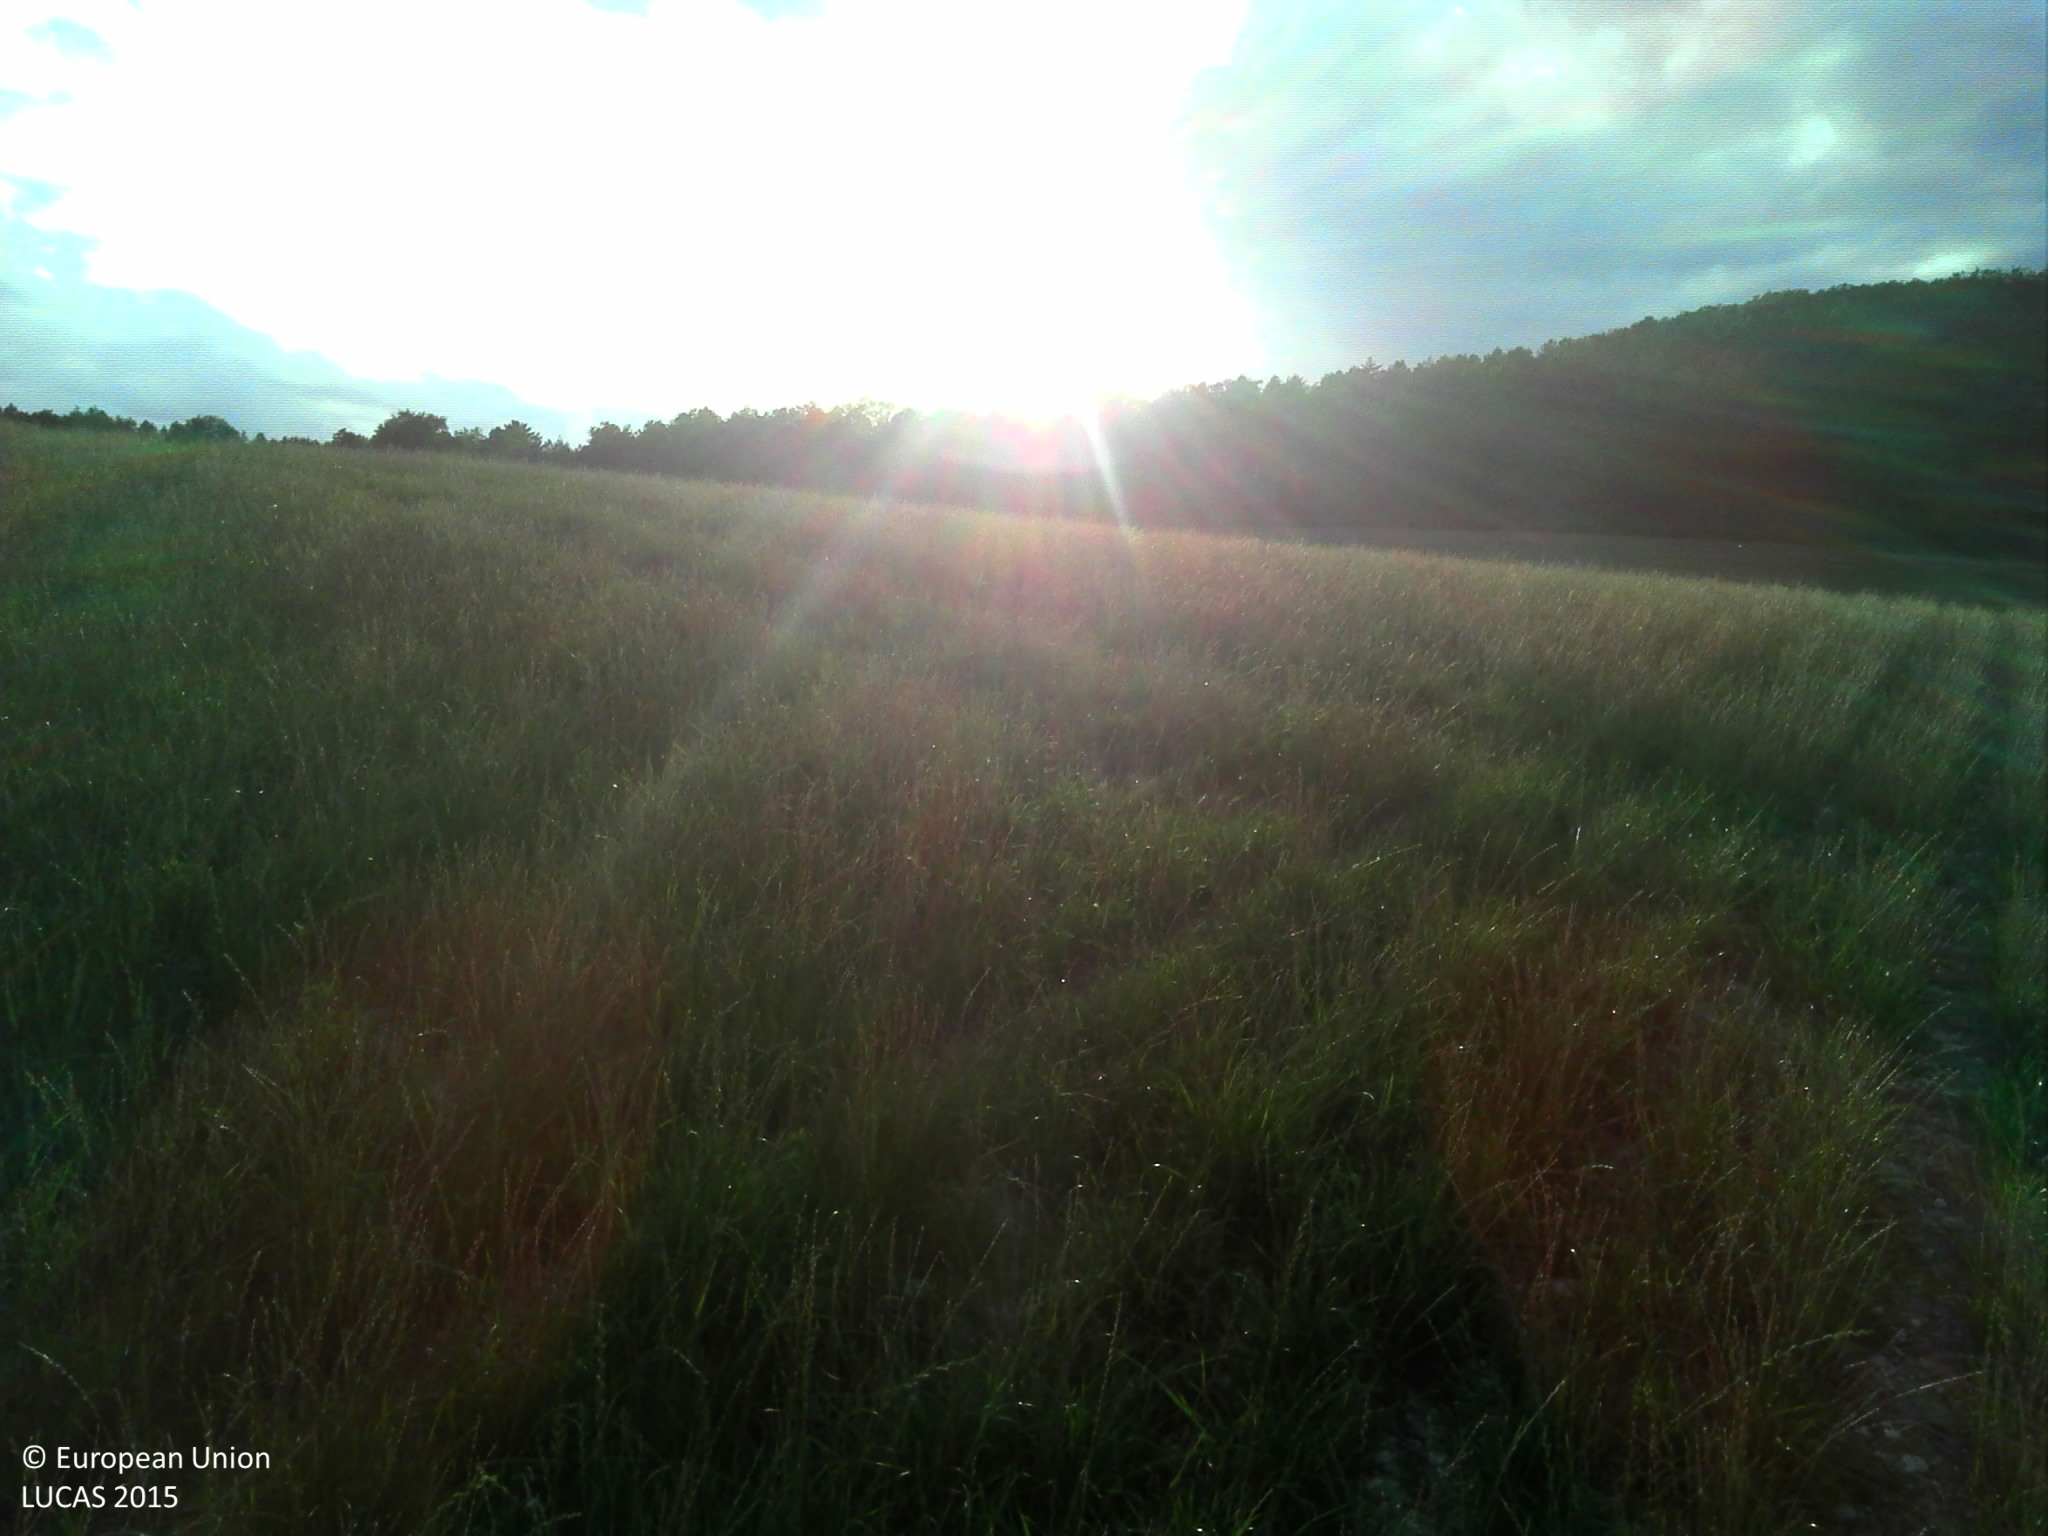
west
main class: Cropland
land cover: Temporary grasslands
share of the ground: > 75 %
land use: Agriculture (excluding fallow land and kitchen gardens)
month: August
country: FR
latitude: 45.2226
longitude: 0.5263
